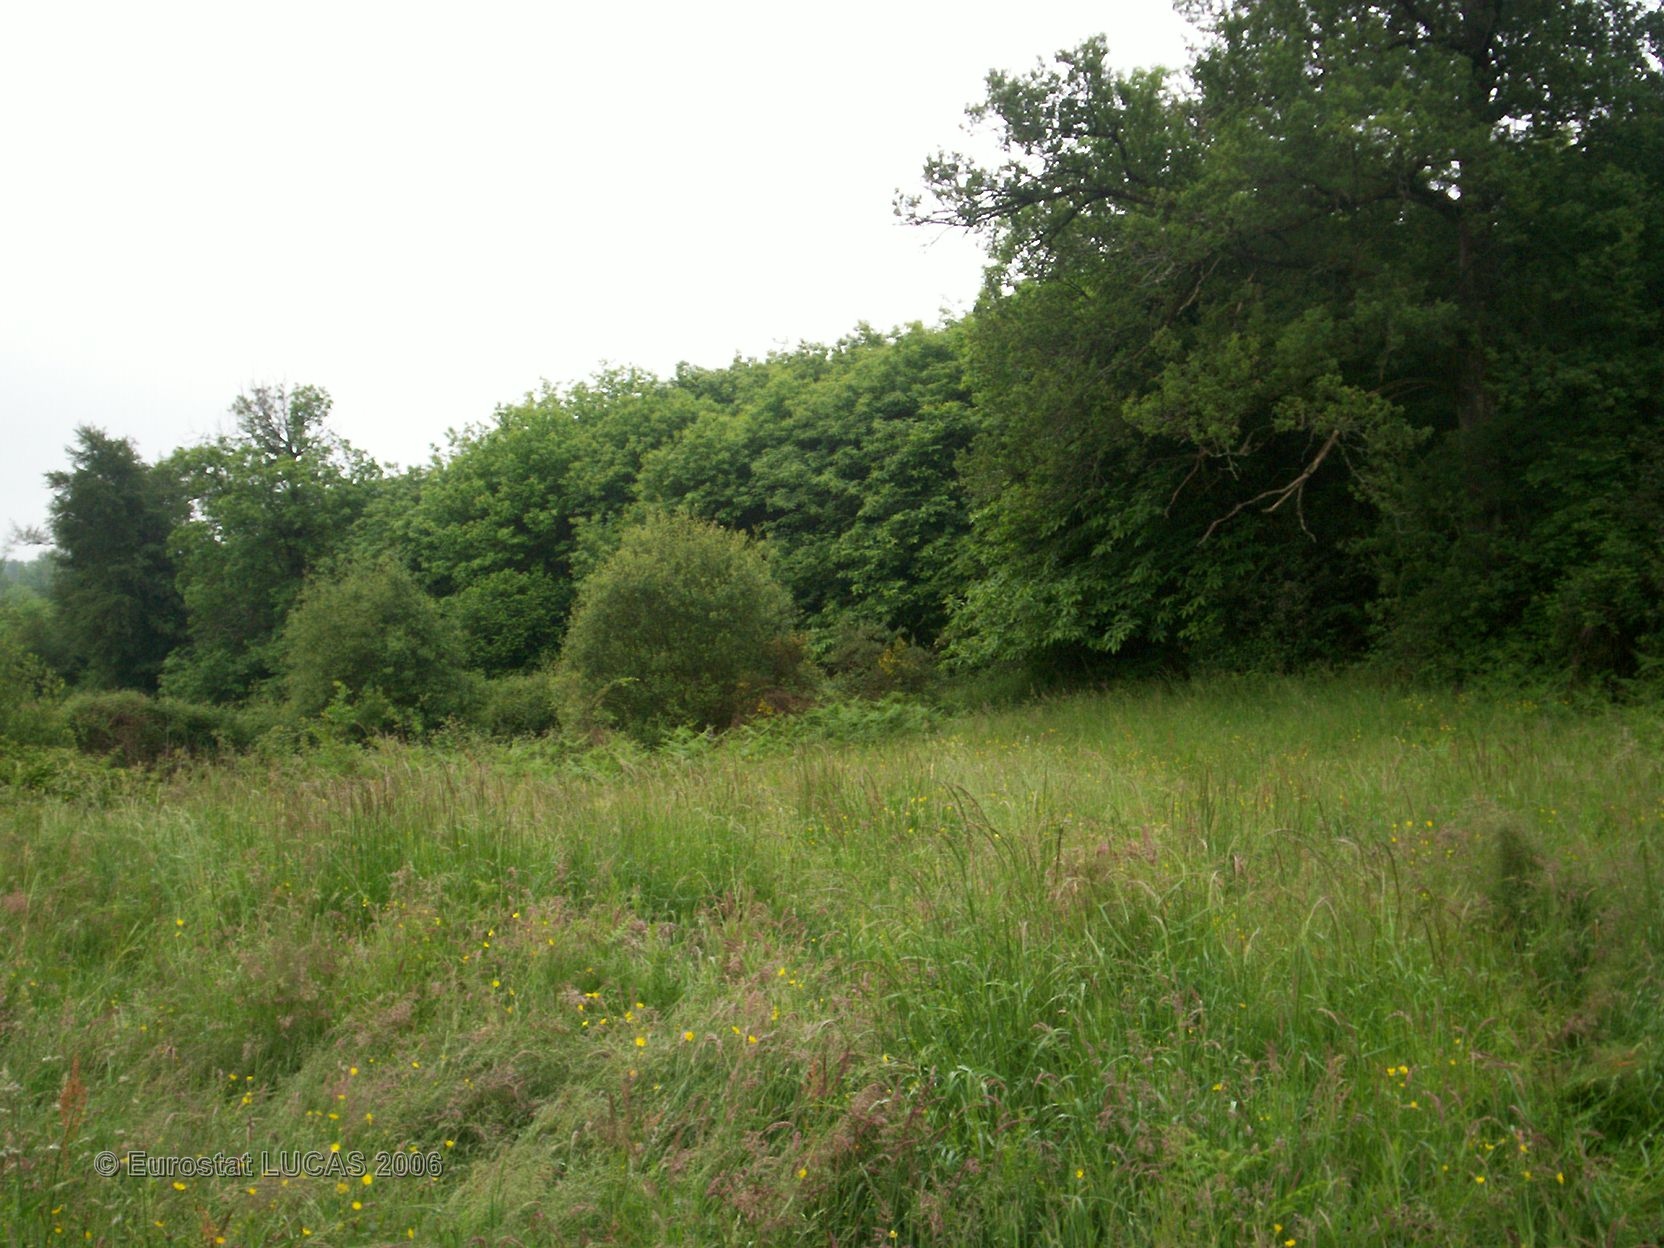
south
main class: Grassland
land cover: Grassland without tree/shrub cover
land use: Agriculture (excluding fallow land and kitchen gardens)
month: May
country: FR
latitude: 45.8213
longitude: 0.7330
